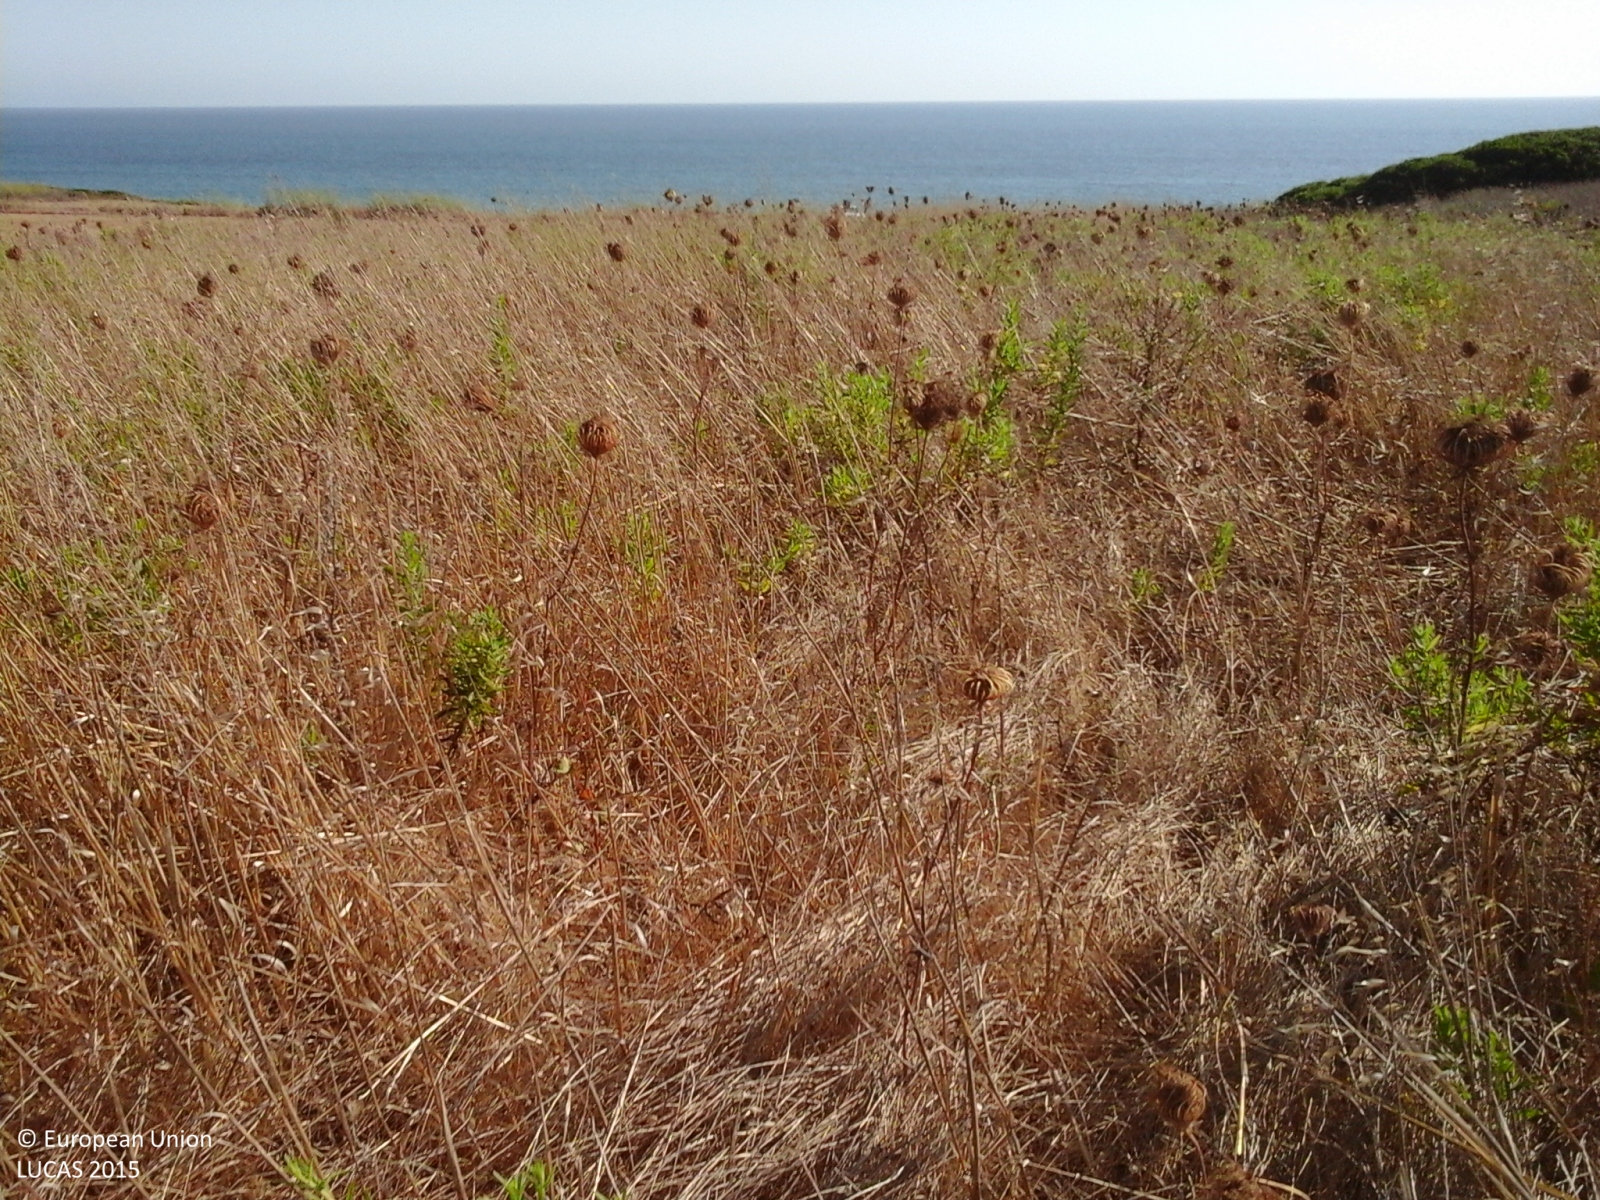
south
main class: Grassland
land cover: Spontaneously vegetated surfaces
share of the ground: > 75 %
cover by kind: herbaceous plants 100 %
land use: Fallow land
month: July
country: IT
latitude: 39.8926
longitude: 8.4299
